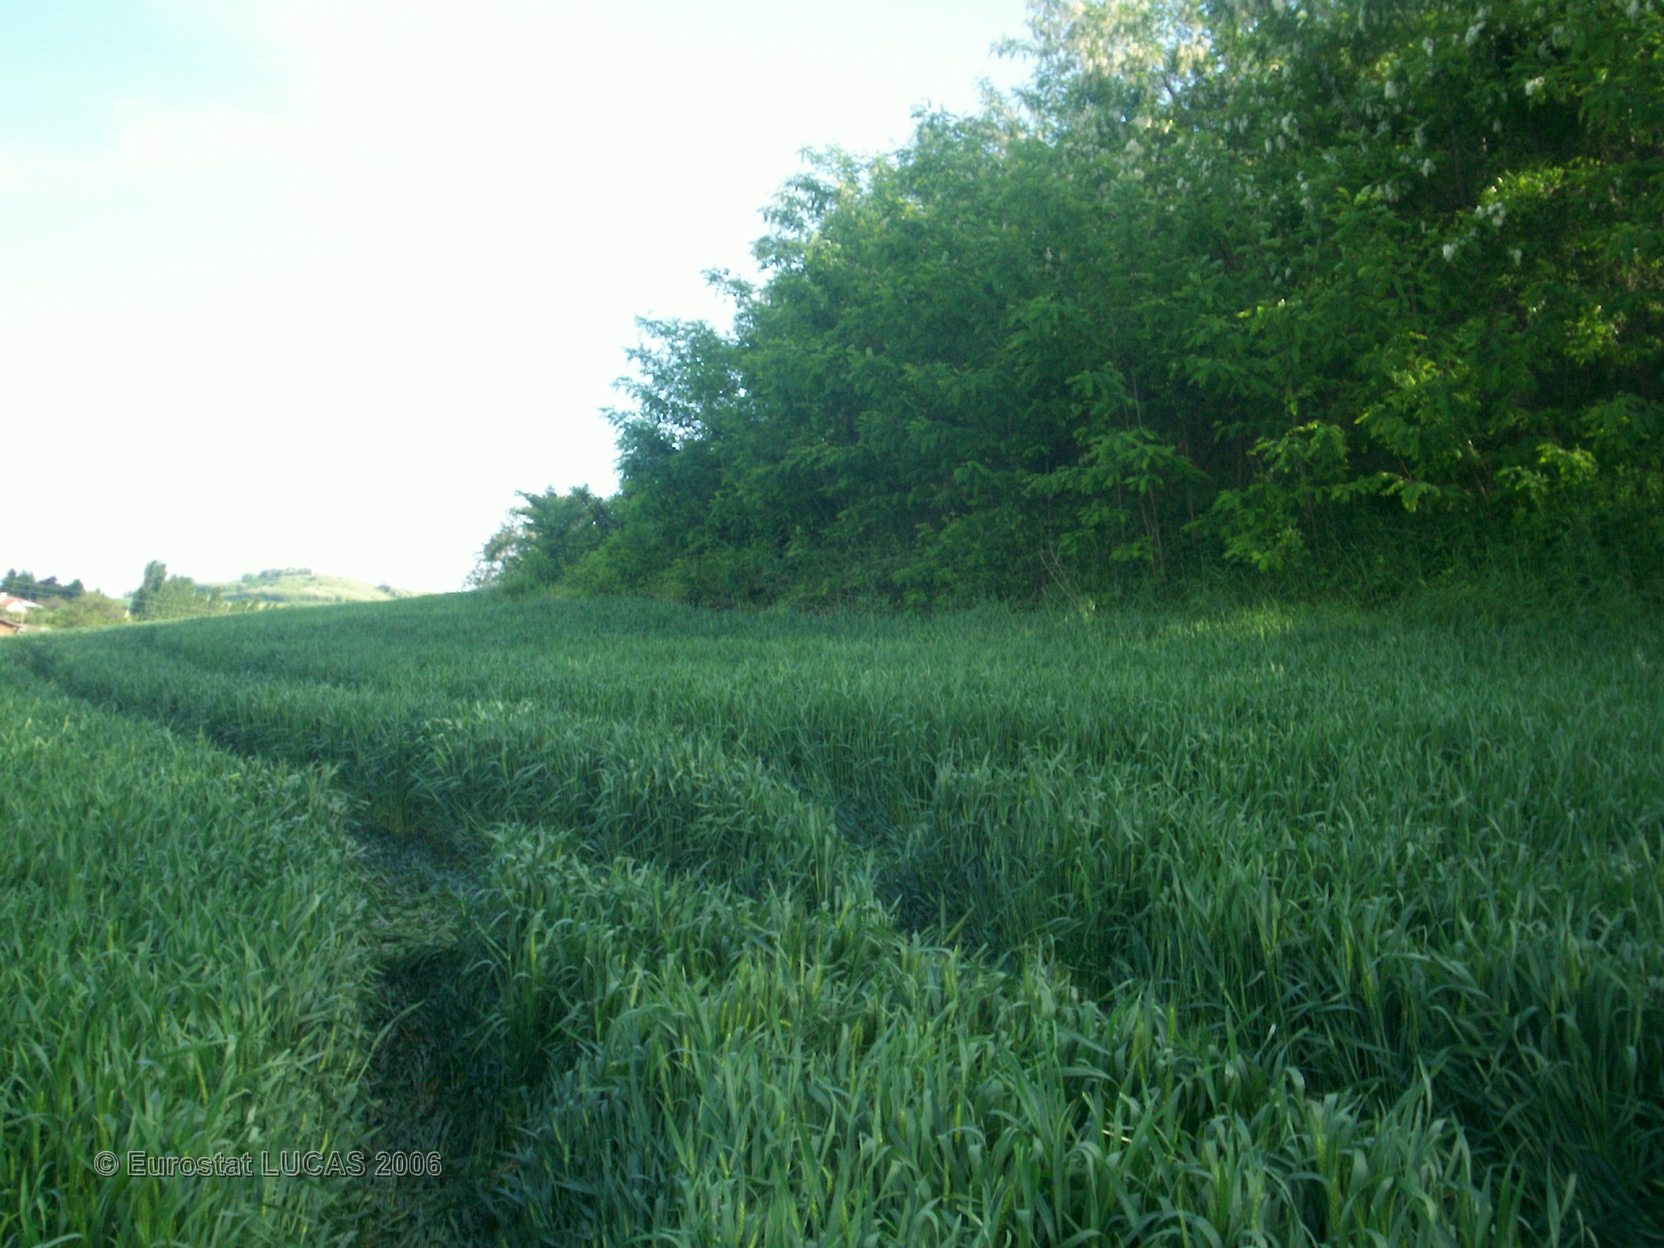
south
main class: Cropland
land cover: Triticale
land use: Agriculture (excluding fallow land and kitchen gardens)
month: May
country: FR
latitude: 45.7600
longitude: 3.2762
